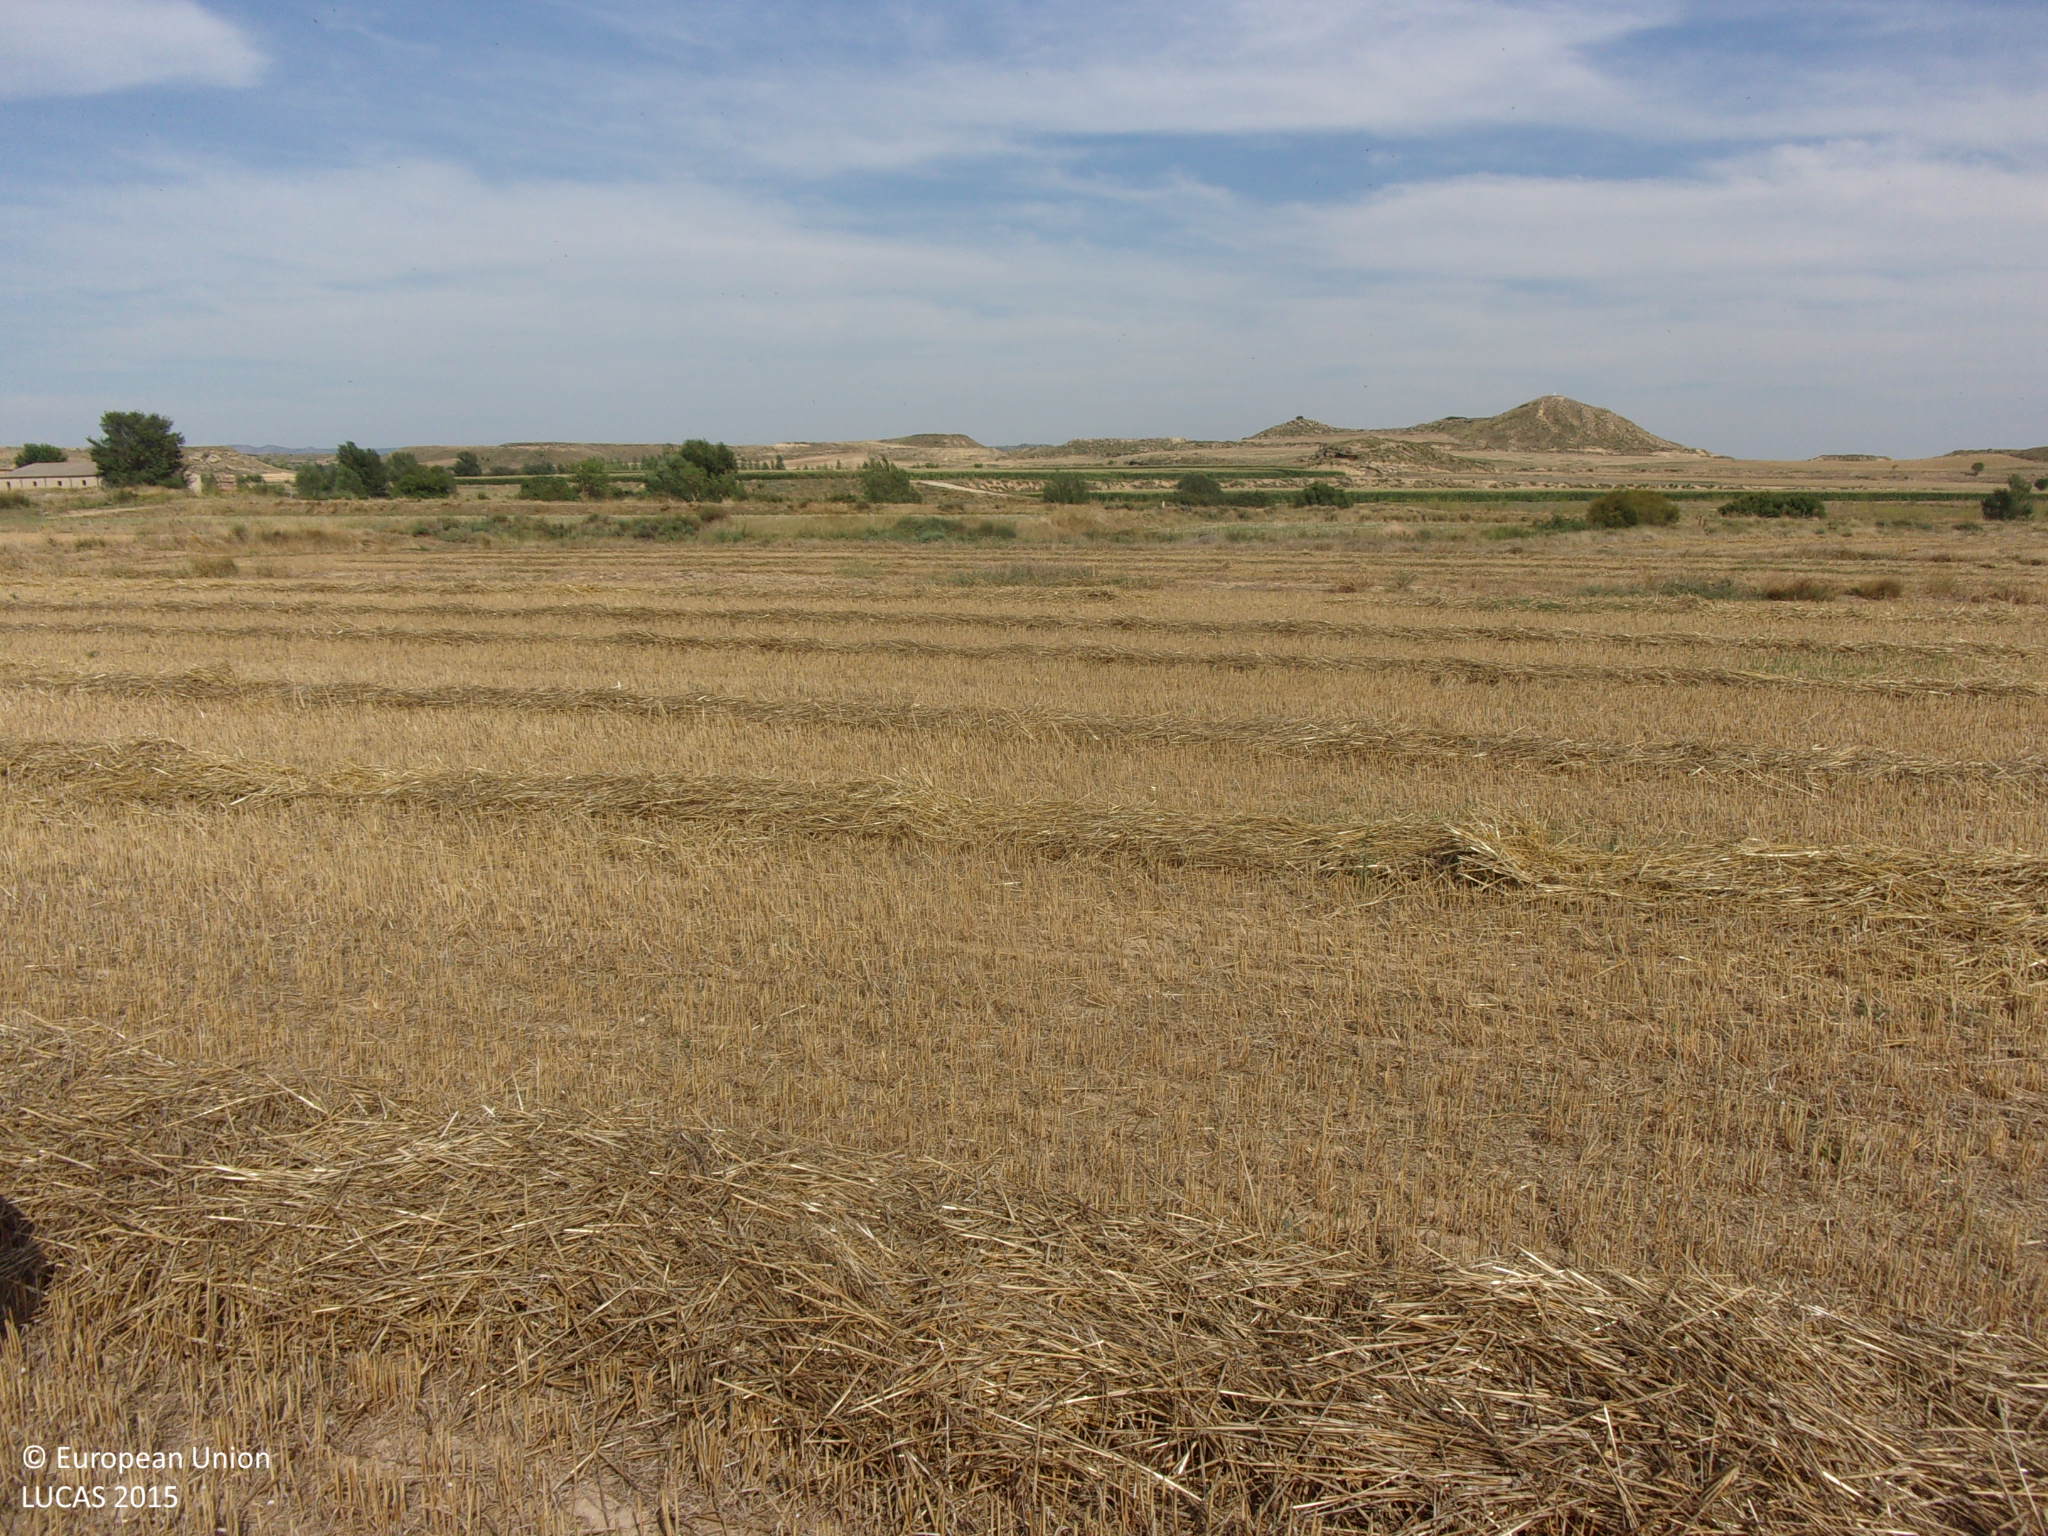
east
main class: Cropland
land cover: Common wheat
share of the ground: < 10 %
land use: Agriculture (excluding fallow land and kitchen gardens)
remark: Harvested field
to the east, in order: Common wheat; Grass margins; Common wheat; Grass margins; Common wheat; Grass margins; Common wheat; Shruby margins; Ditches and canals; Shruby margins; Rape and turnip rape; Shruby margins; Rape and turnip rape; Shruby margins; Tracks; Grassland without tree/shrub cover; Rivers and streams; Shrubland with sparse tree cover; Grassland without tree/shrub cover; Tracks
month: August
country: ES
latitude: 42.1994
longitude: -1.1587
